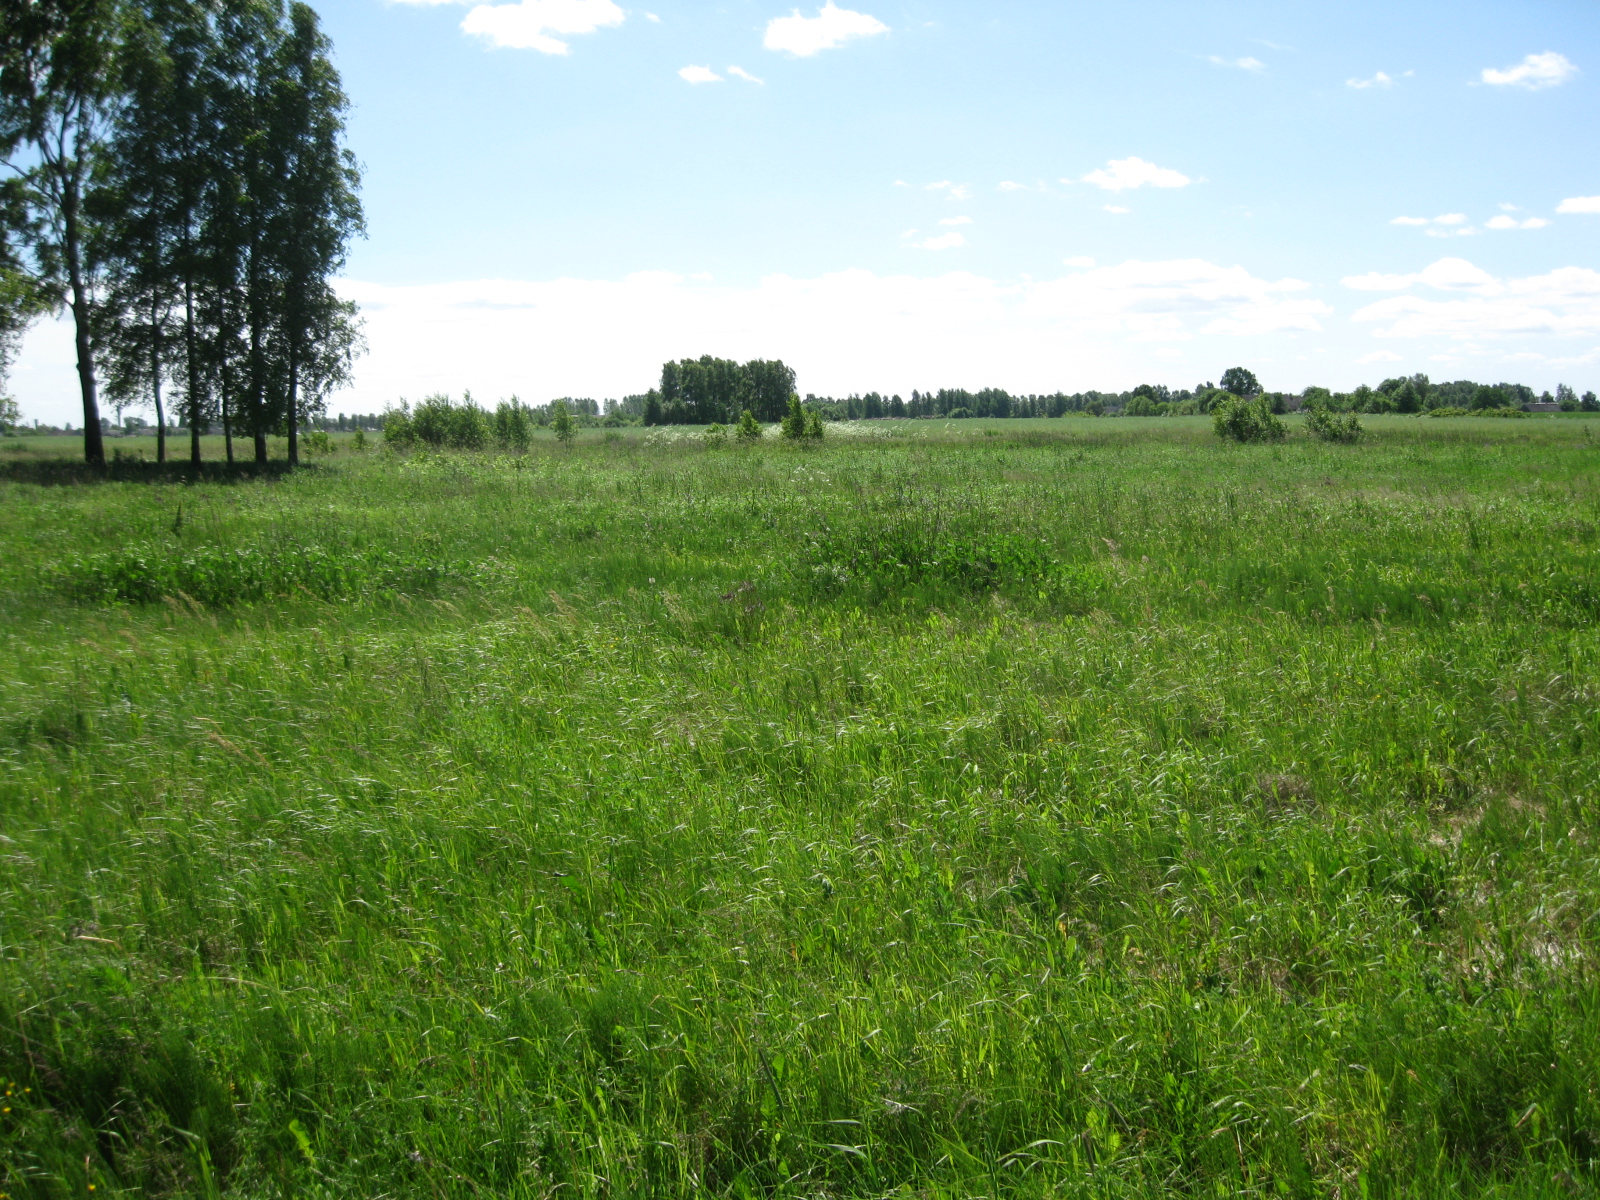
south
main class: Grassland
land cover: Grassland without tree/shrub cover
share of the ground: > 75 %
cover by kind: herbaceous plants 100 %
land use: Agriculture (excluding fallow land and kitchen gardens)
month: June
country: LT
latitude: 55.2278
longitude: 23.8759
